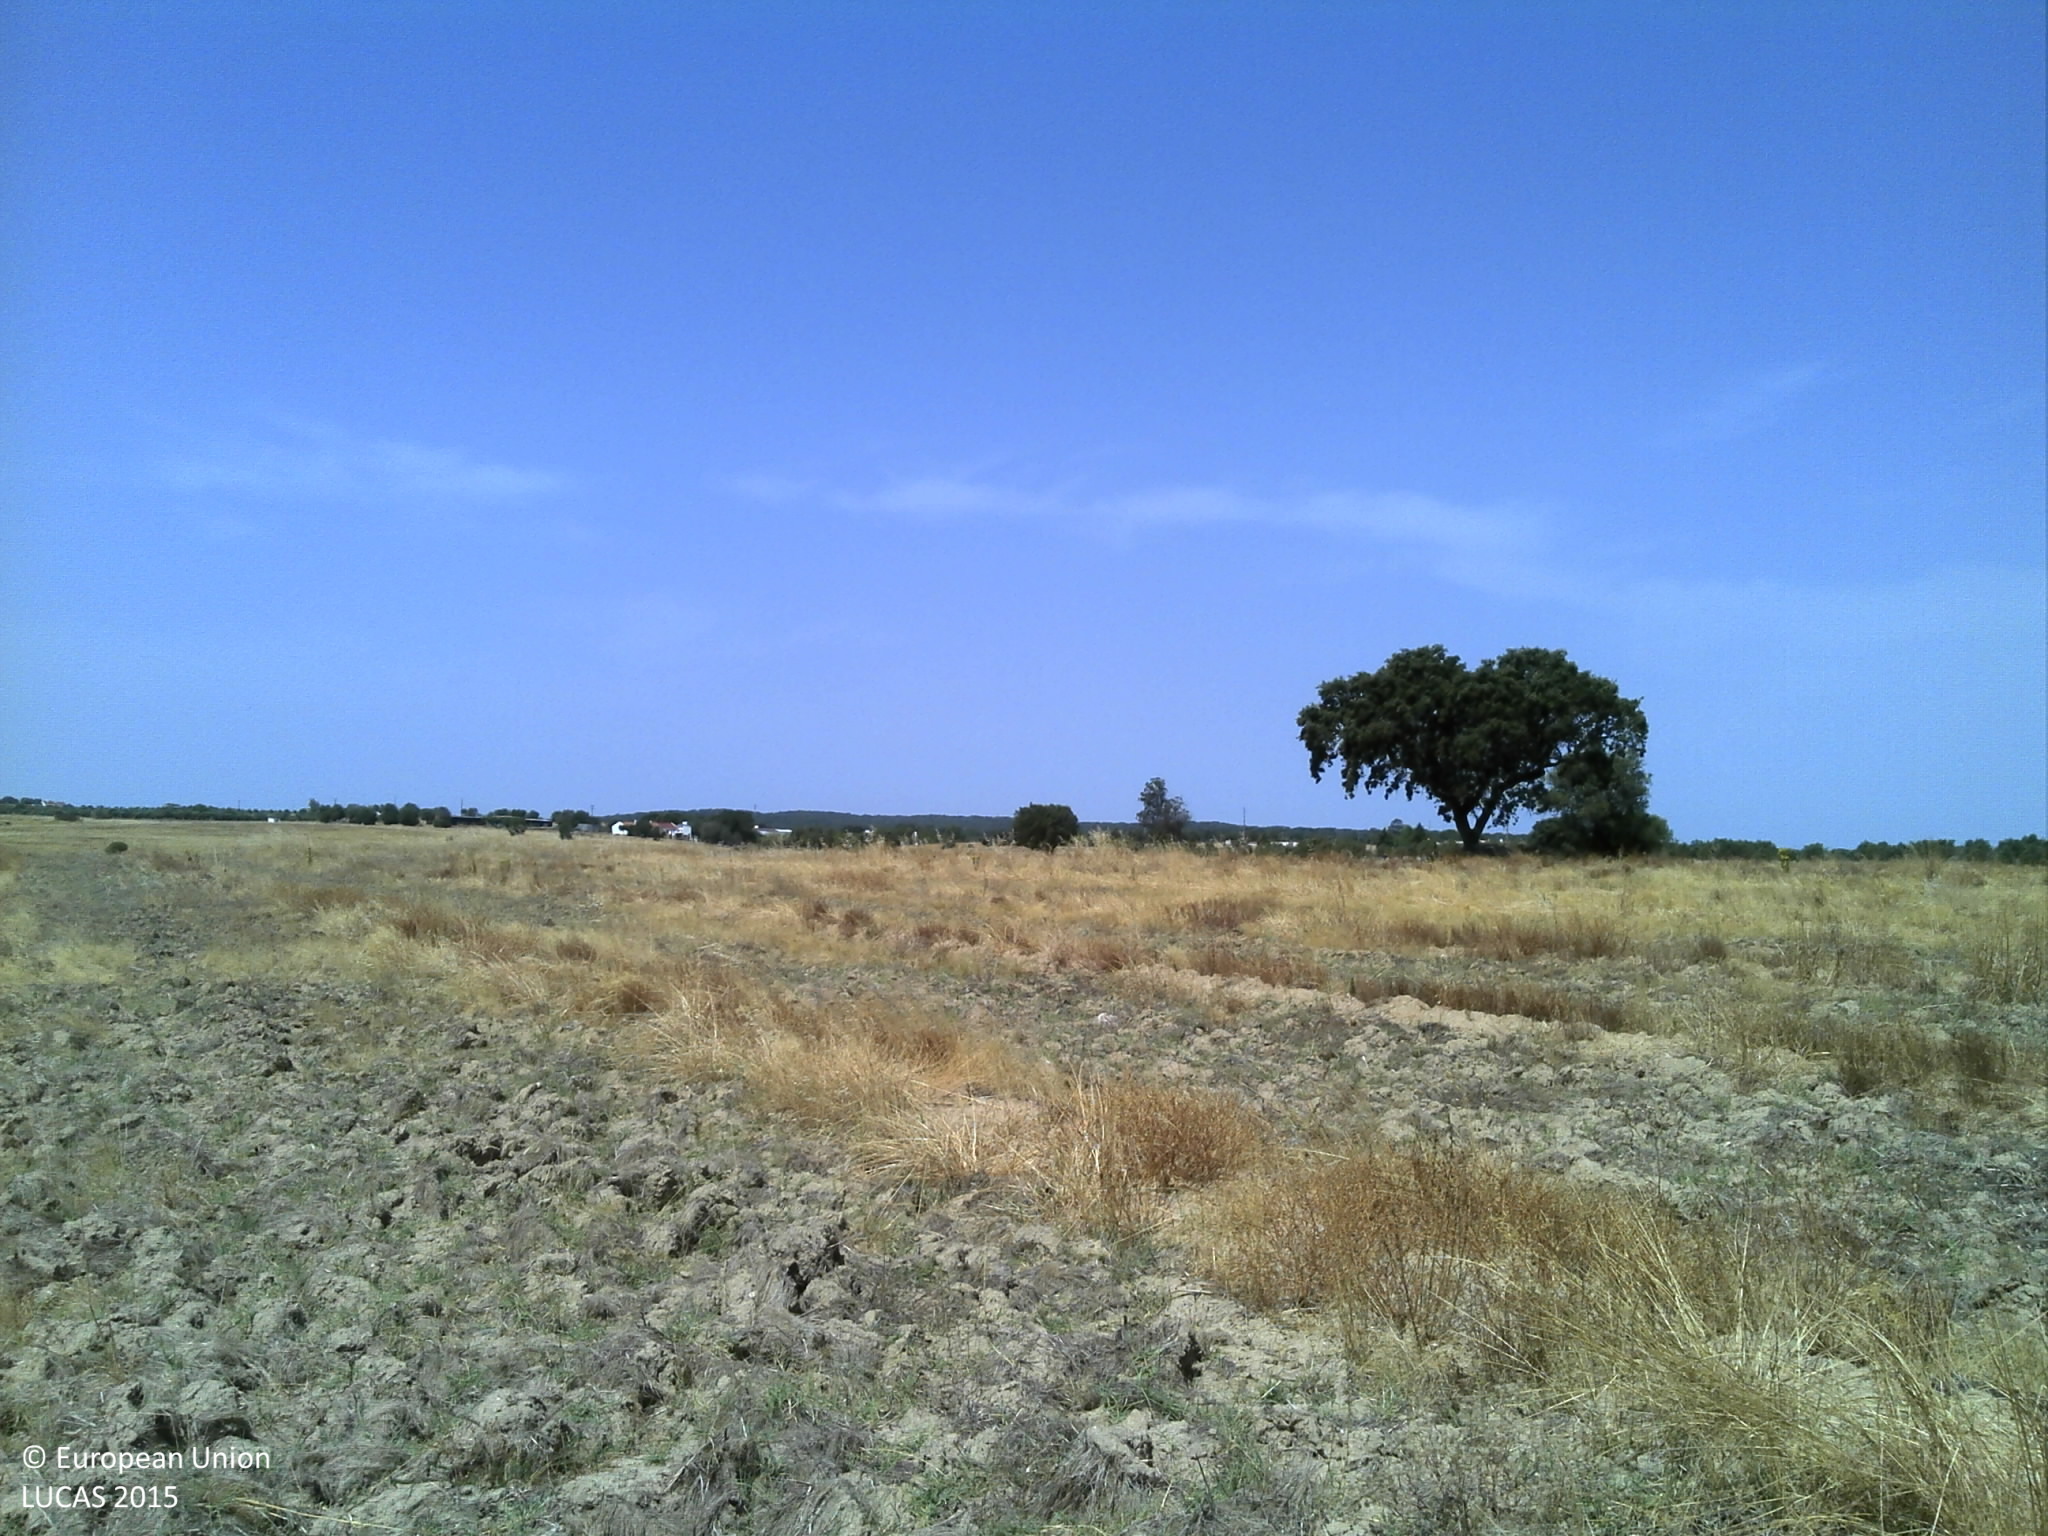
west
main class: Grassland
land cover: Grassland without tree/shrub cover
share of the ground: 10 - 25 %
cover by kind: unconsolidated bare surface 85 %, herbaceous plants 15 %
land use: Agriculture (excluding fallow land and kitchen gardens)
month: July
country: PT
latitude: 38.6888
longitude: -7.7541
